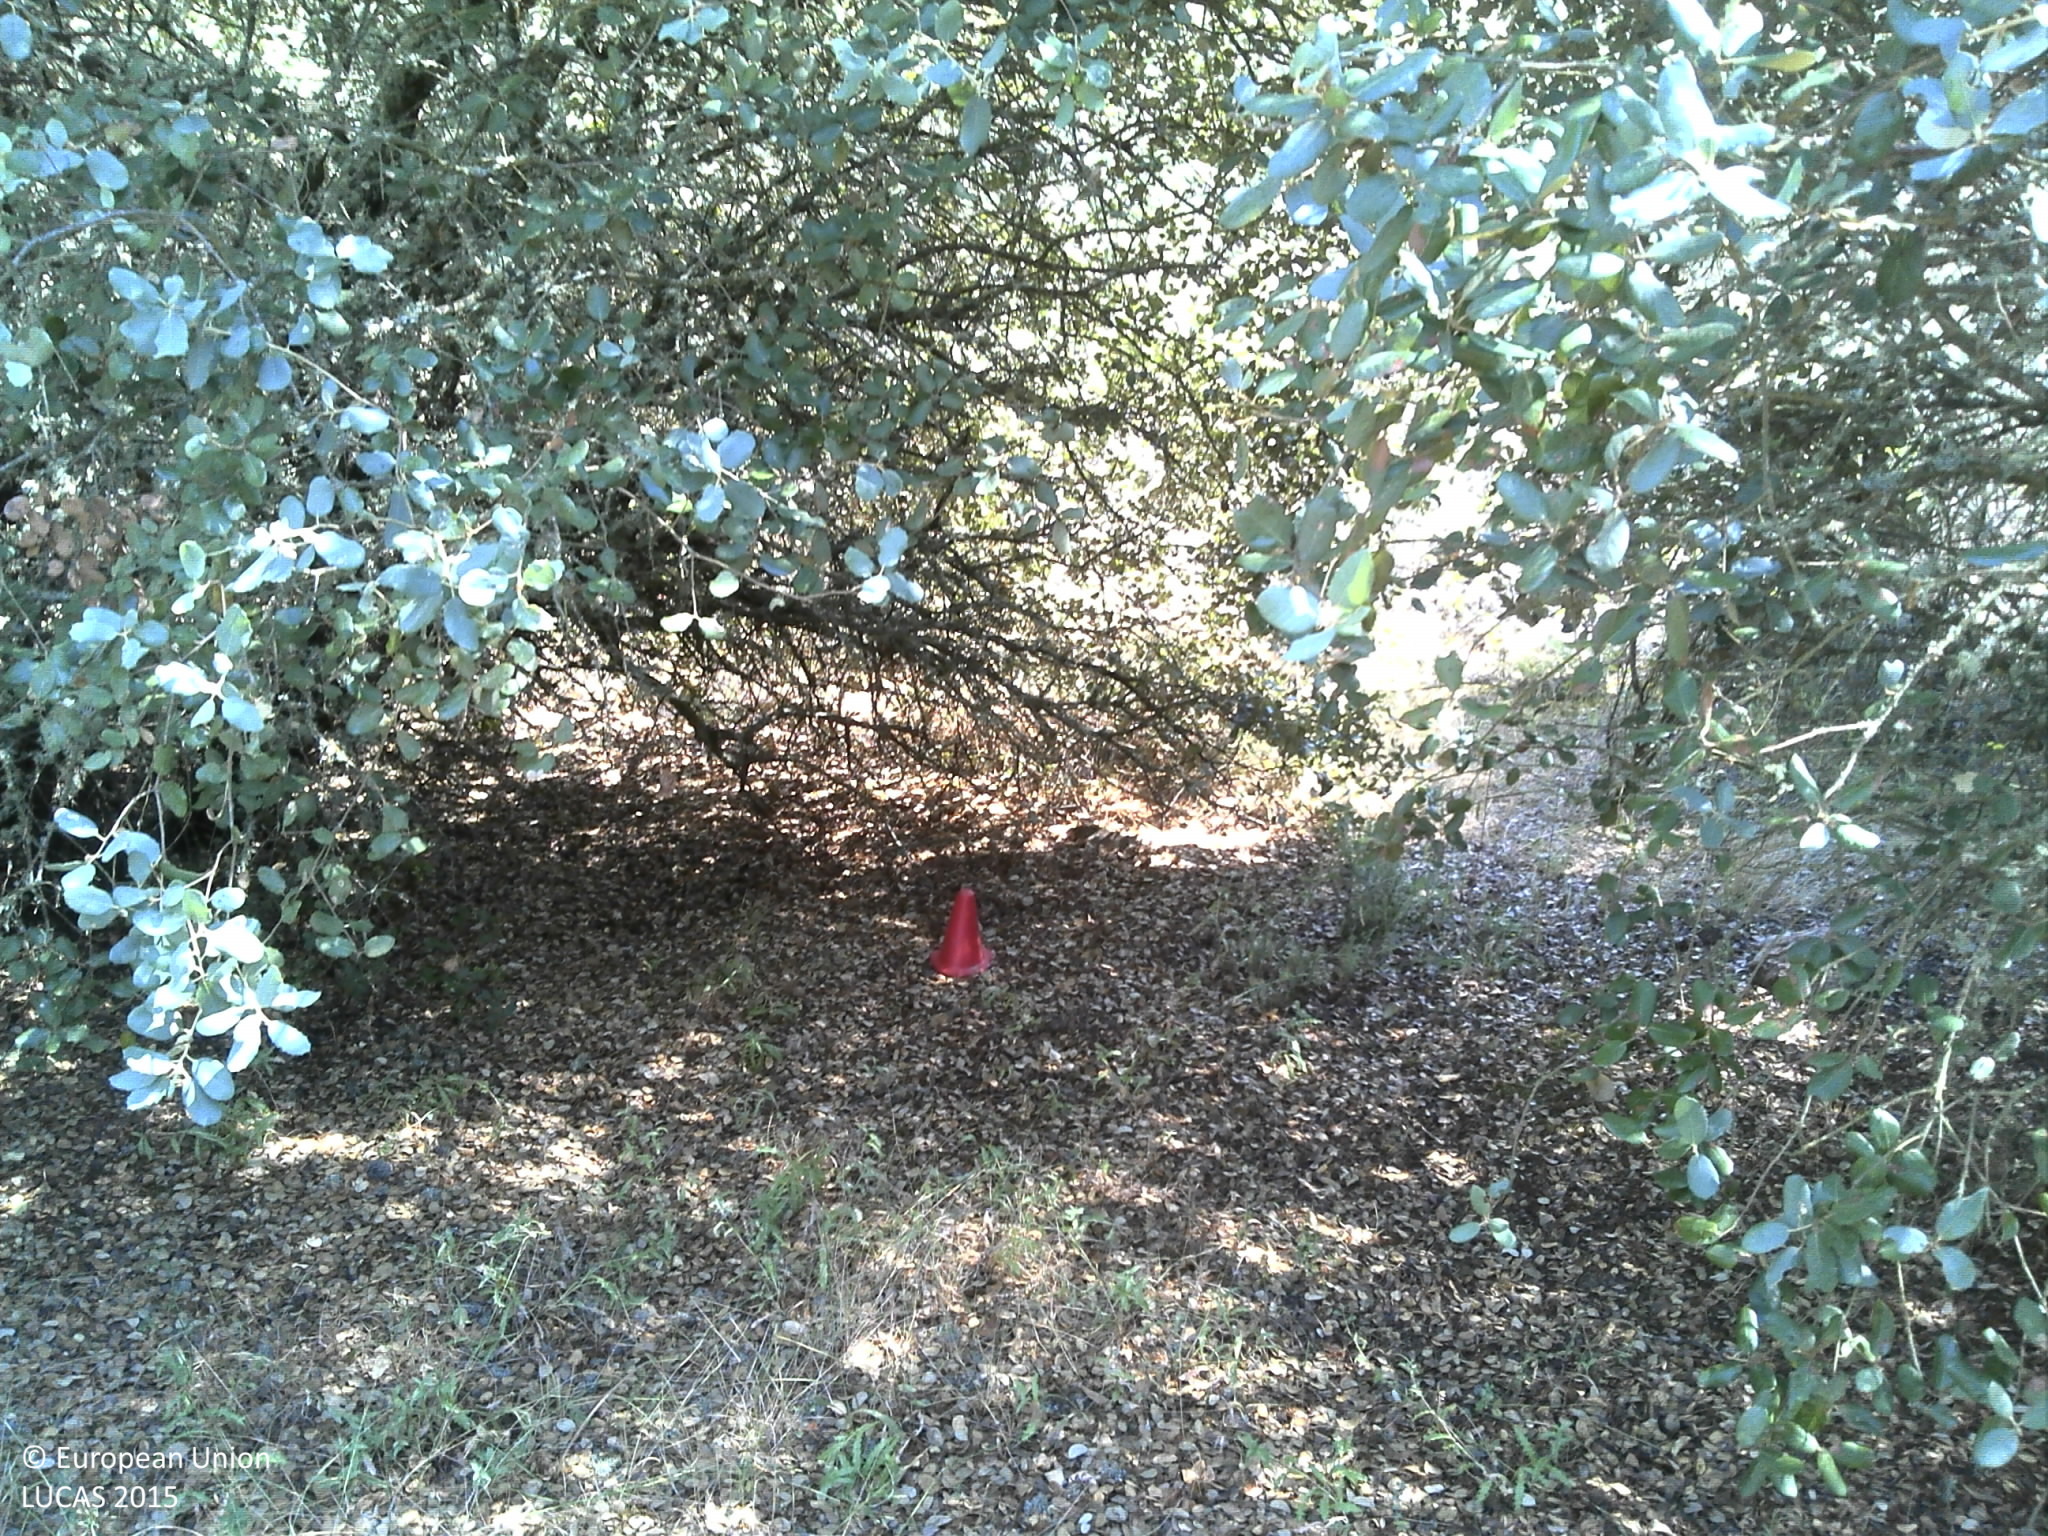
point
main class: Woodland
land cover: Broadleaved woodland
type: broadleaved evergreen forest
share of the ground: 25 - 50 %
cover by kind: shrubs 40 %, herbaceous plants 30 %, broadleaved forest trees 25 %, unconsolidated bare surface 5 %
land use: Forestry
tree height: > 5 m
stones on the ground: < 10 %
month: June
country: PT
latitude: 40.8556
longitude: -6.8875
